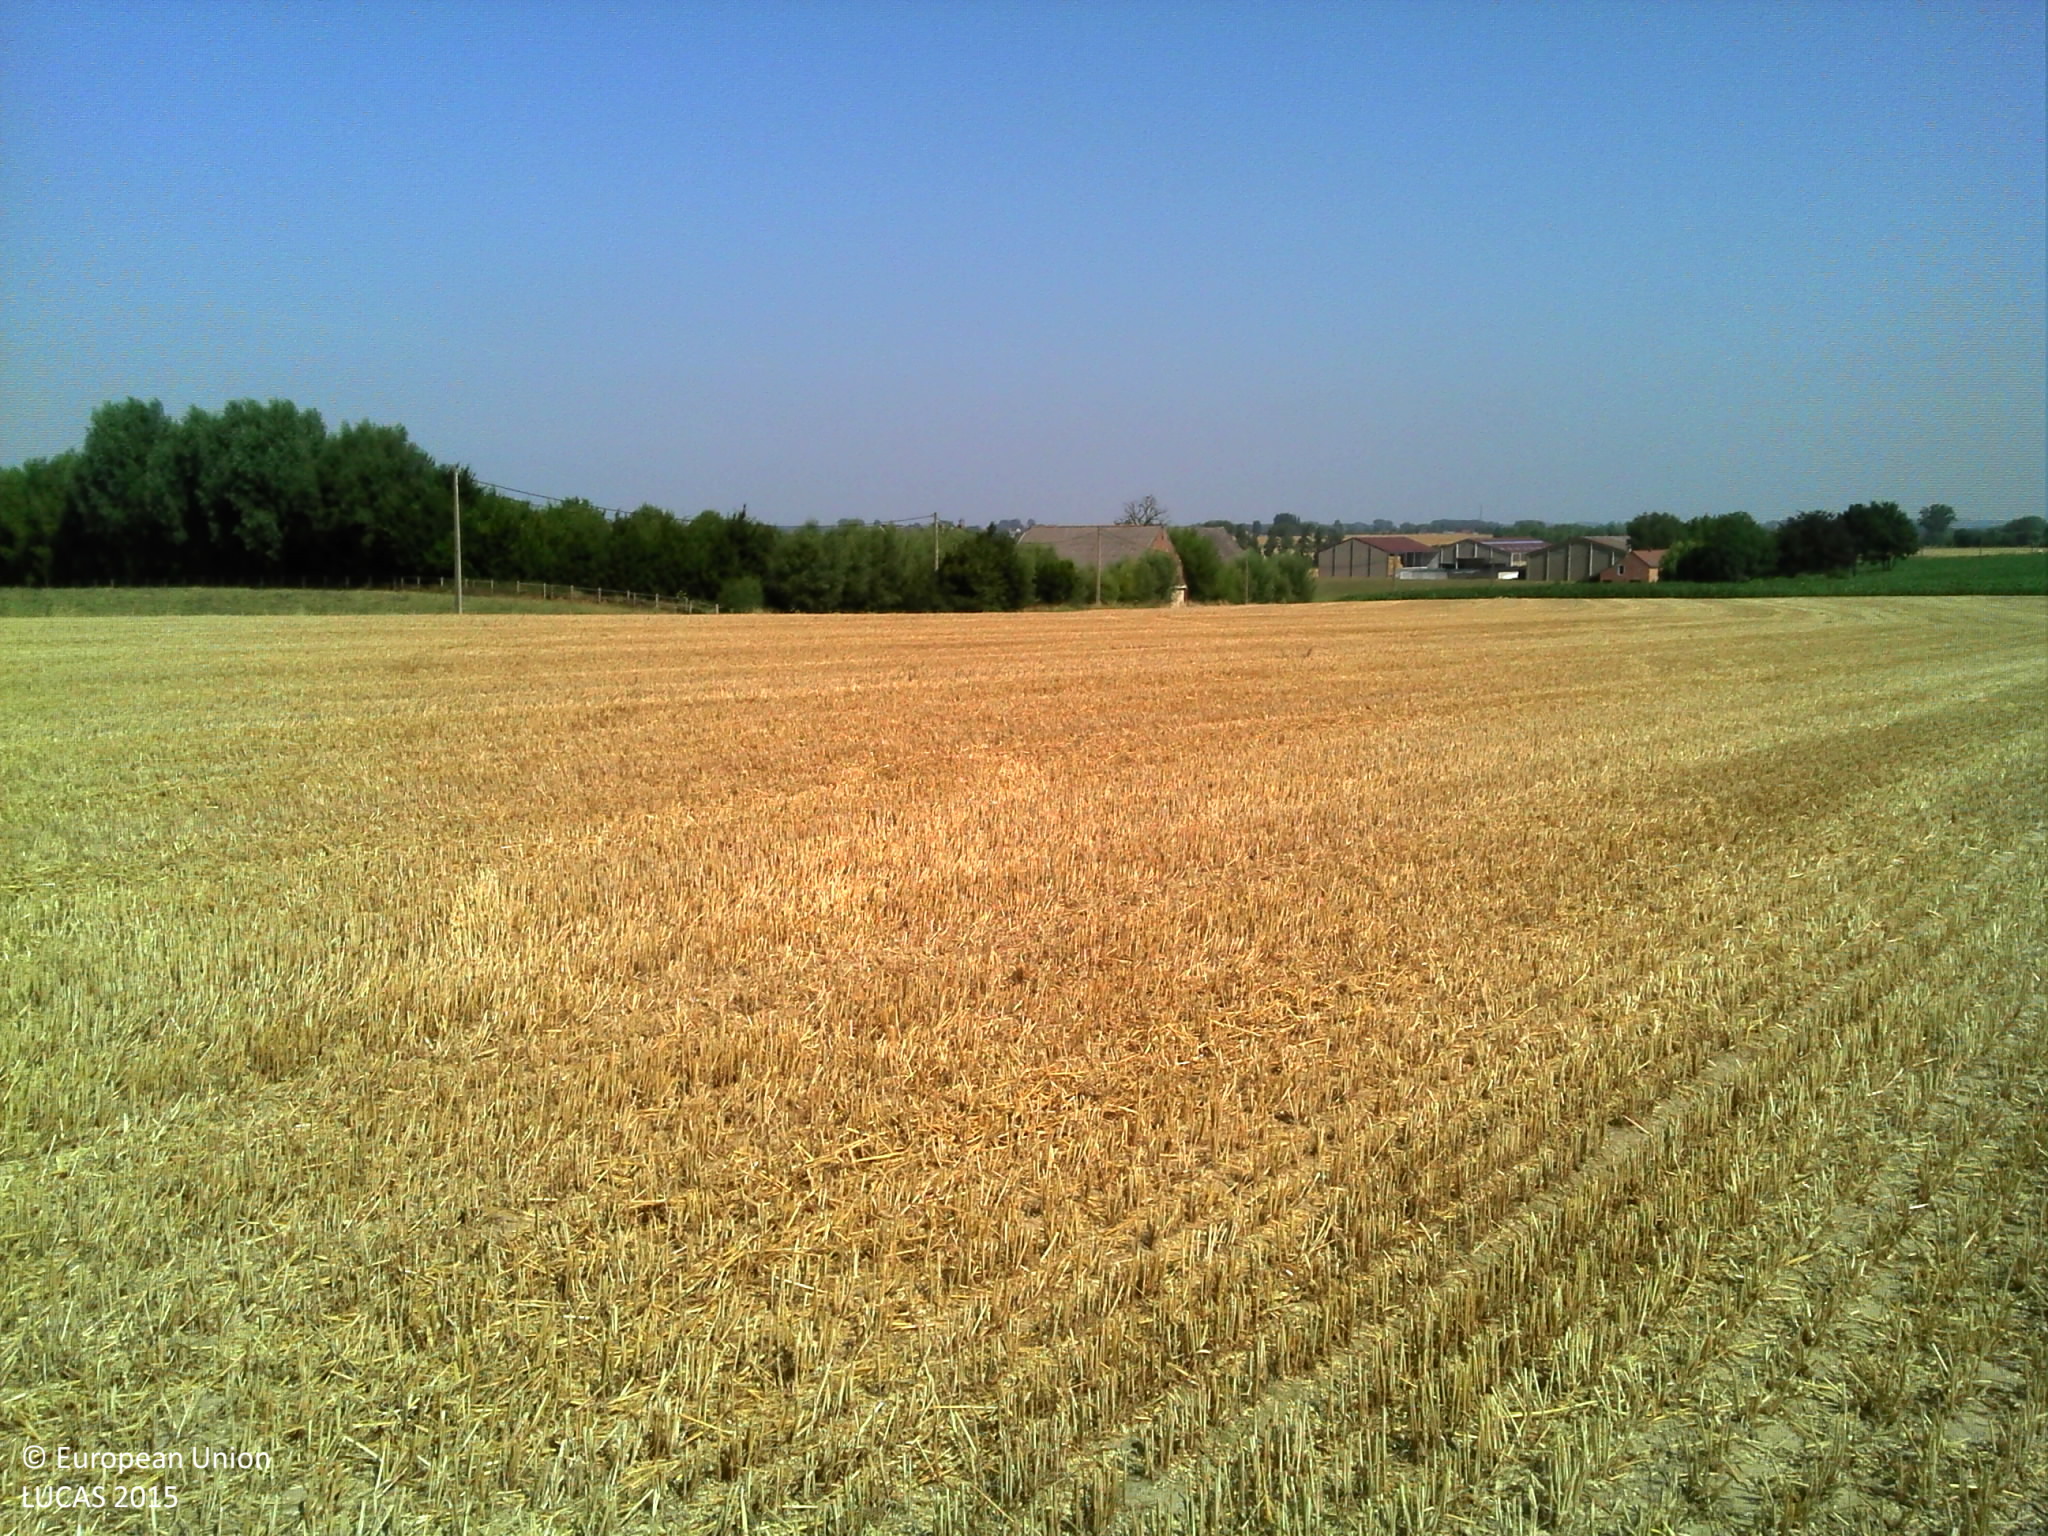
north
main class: Cropland
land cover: Common wheat
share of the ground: < 10 %
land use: Agriculture (excluding fallow land and kitchen gardens)
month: August
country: BE
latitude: 50.6564
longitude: 3.9824
